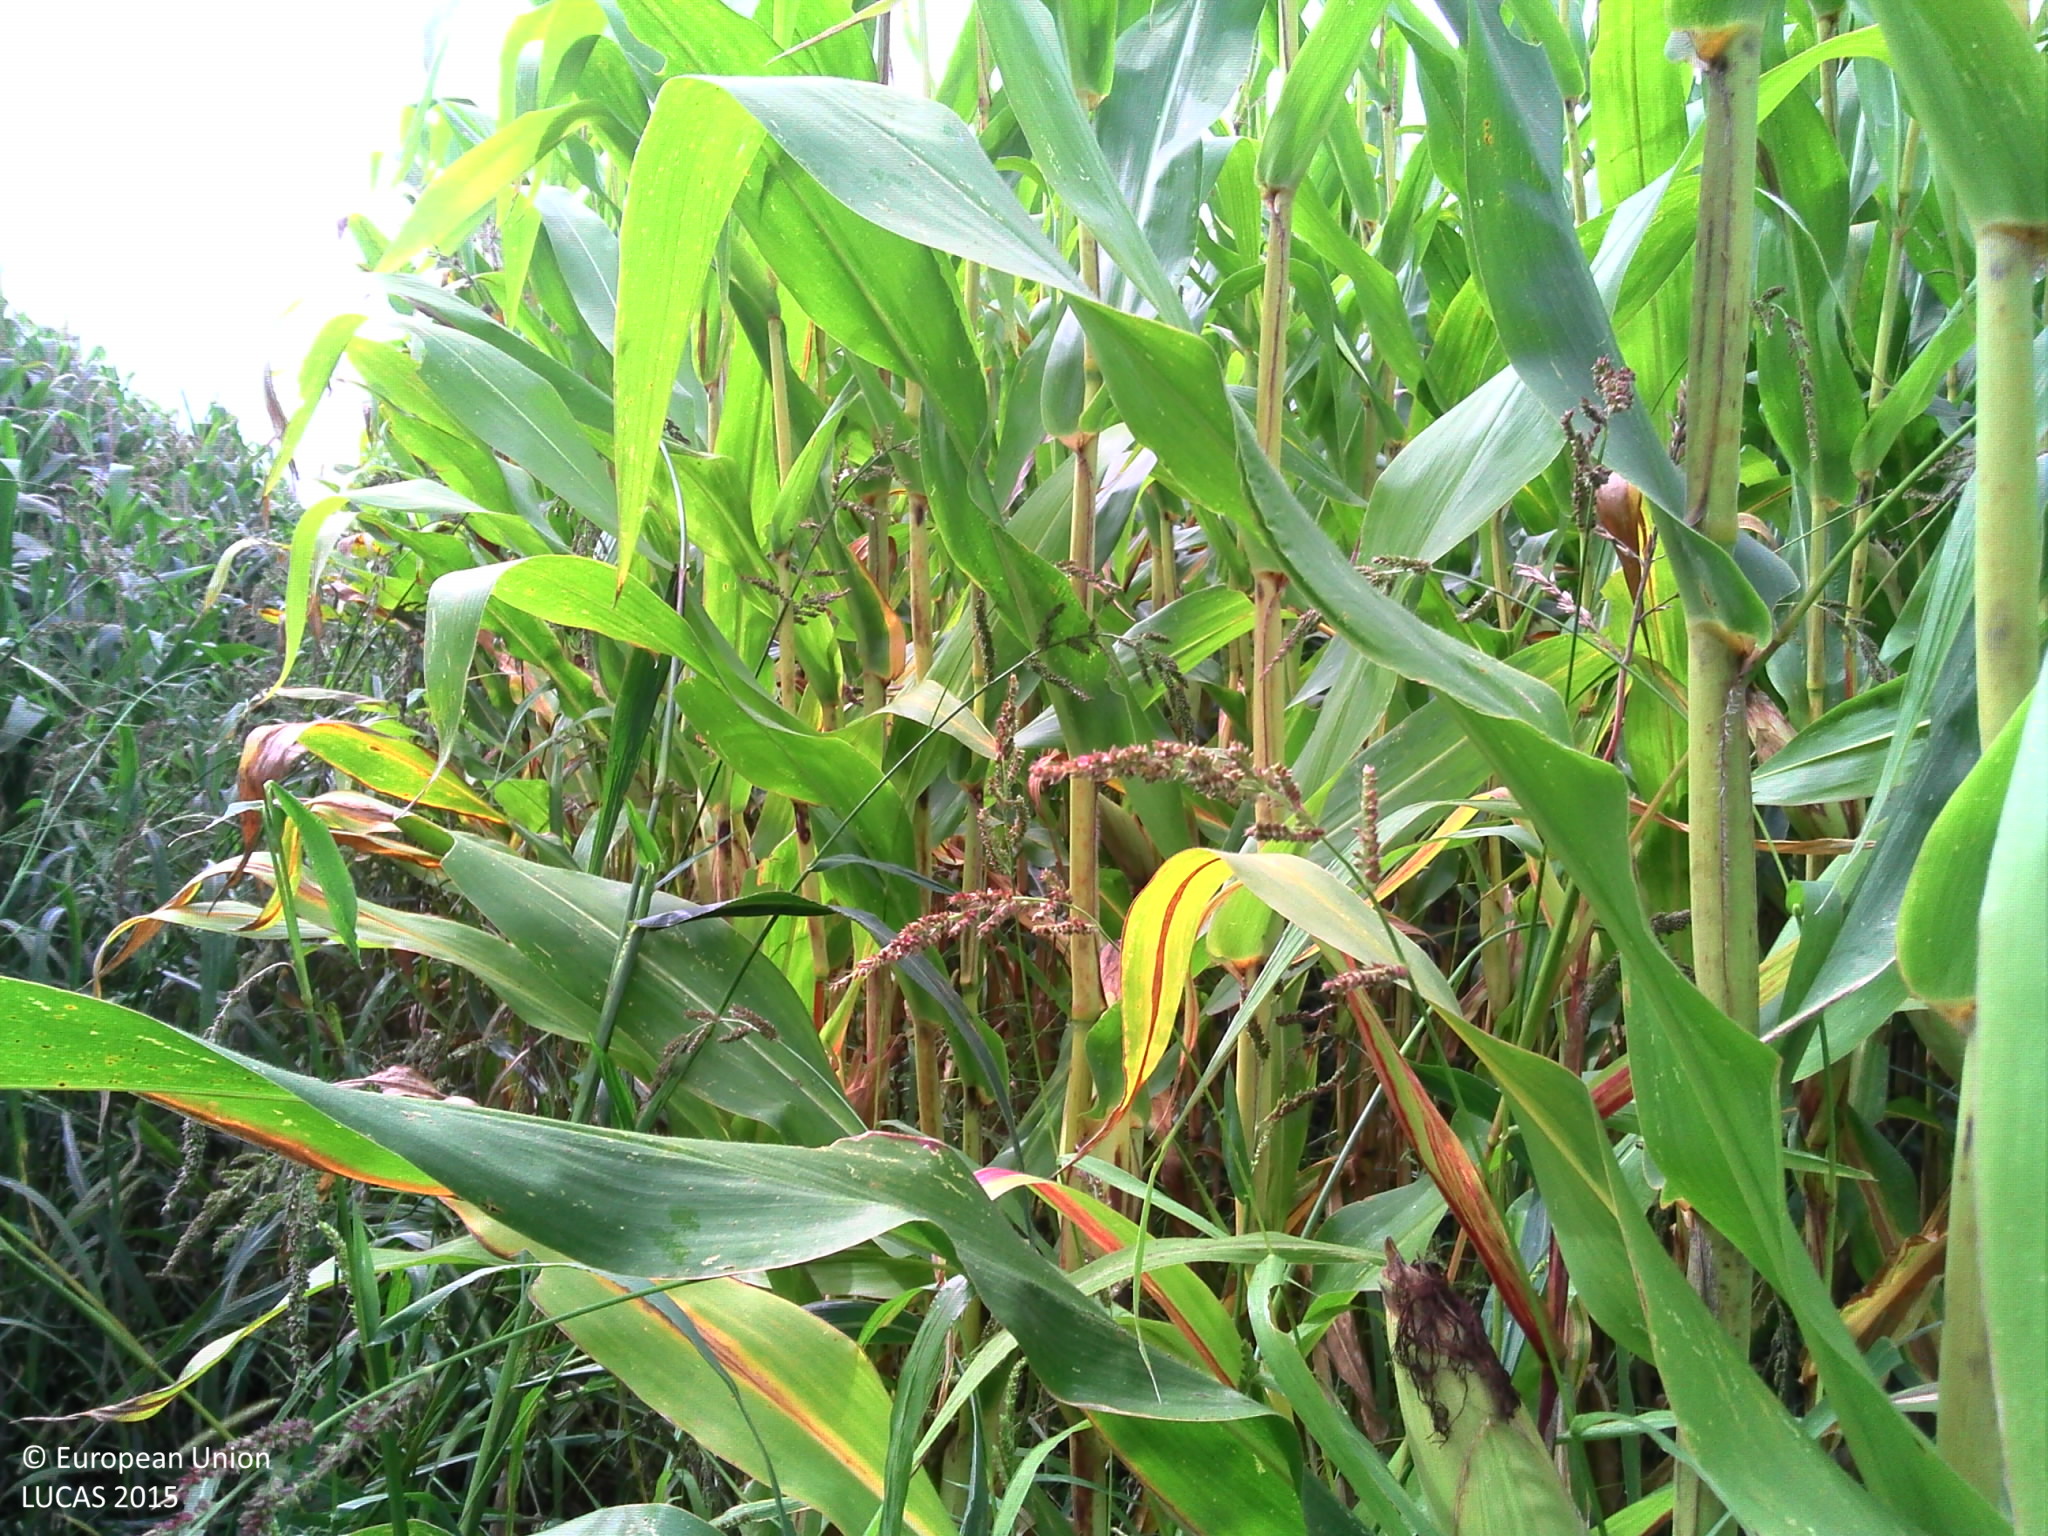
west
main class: Cropland
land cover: Maize
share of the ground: > 75 %
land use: Agriculture (excluding fallow land and kitchen gardens)
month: September
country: FR
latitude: 43.3242
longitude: -0.1543
